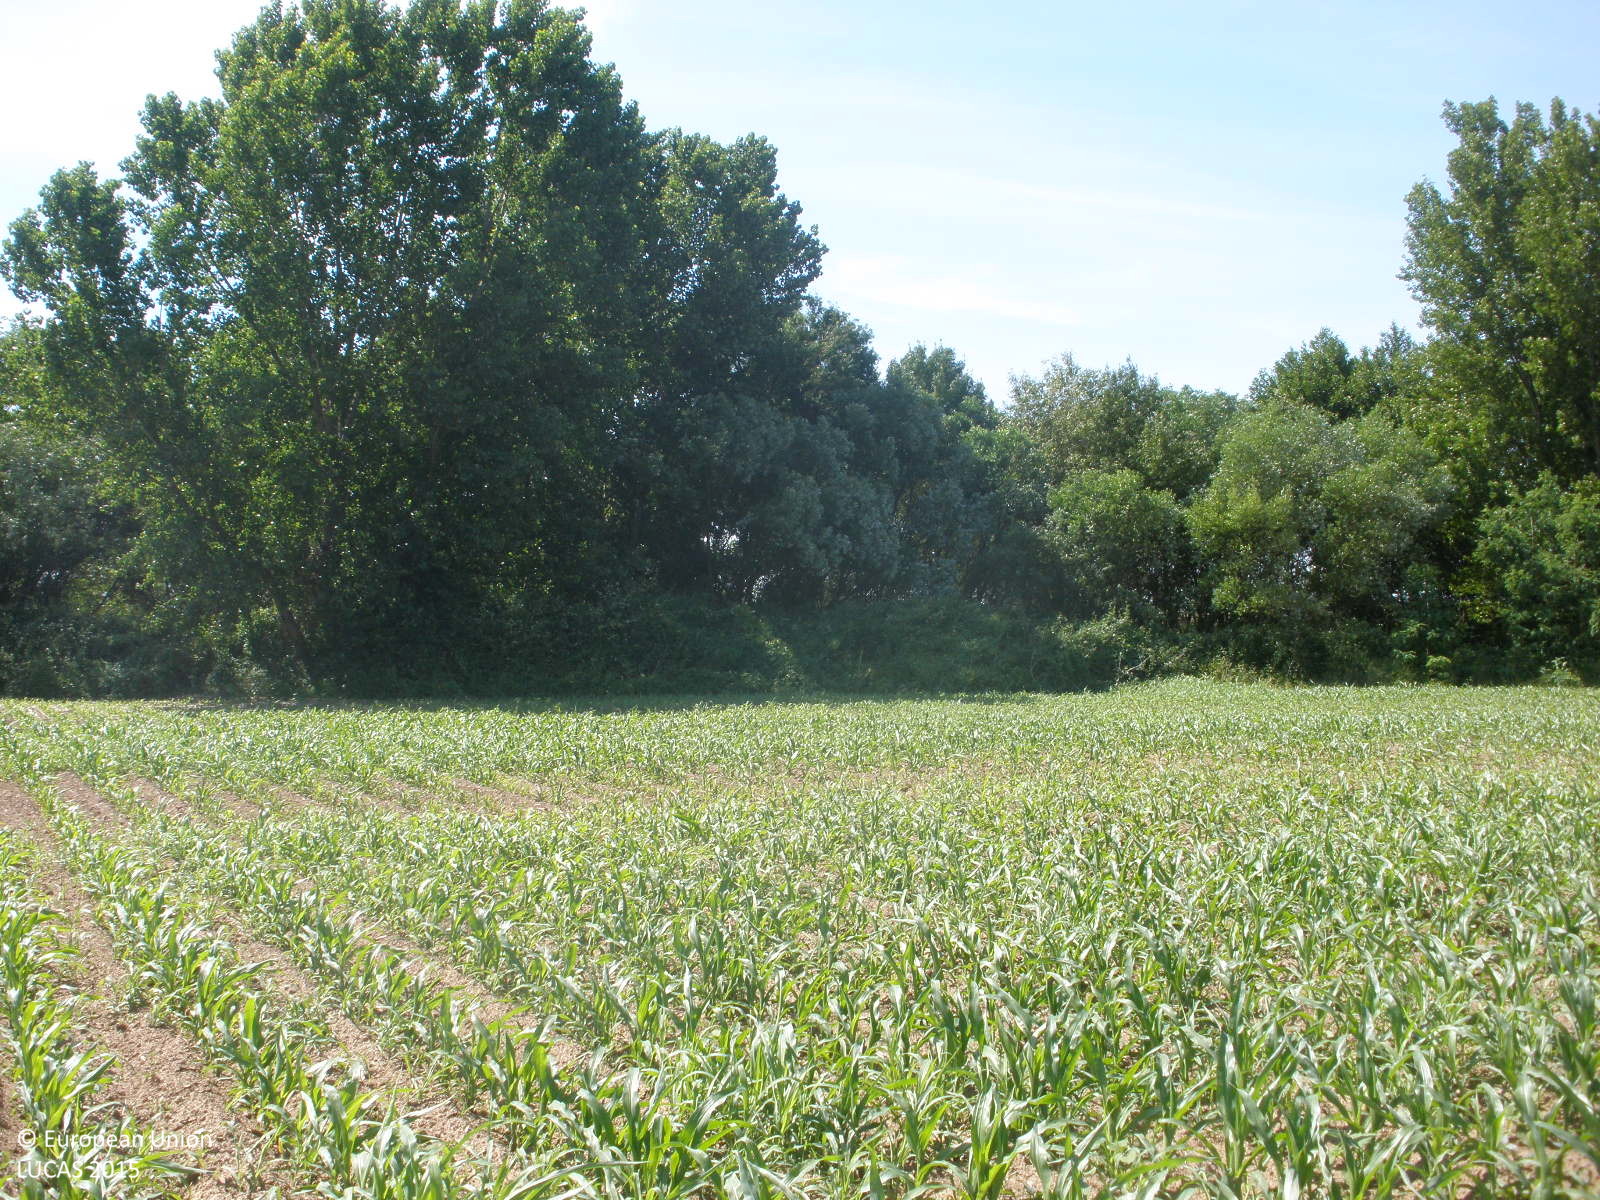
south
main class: Cropland
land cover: Maize
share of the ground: 50 - 75 %
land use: Agriculture (excluding fallow land and kitchen gardens)
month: May
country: ES
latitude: 40.0931
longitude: -6.6098
